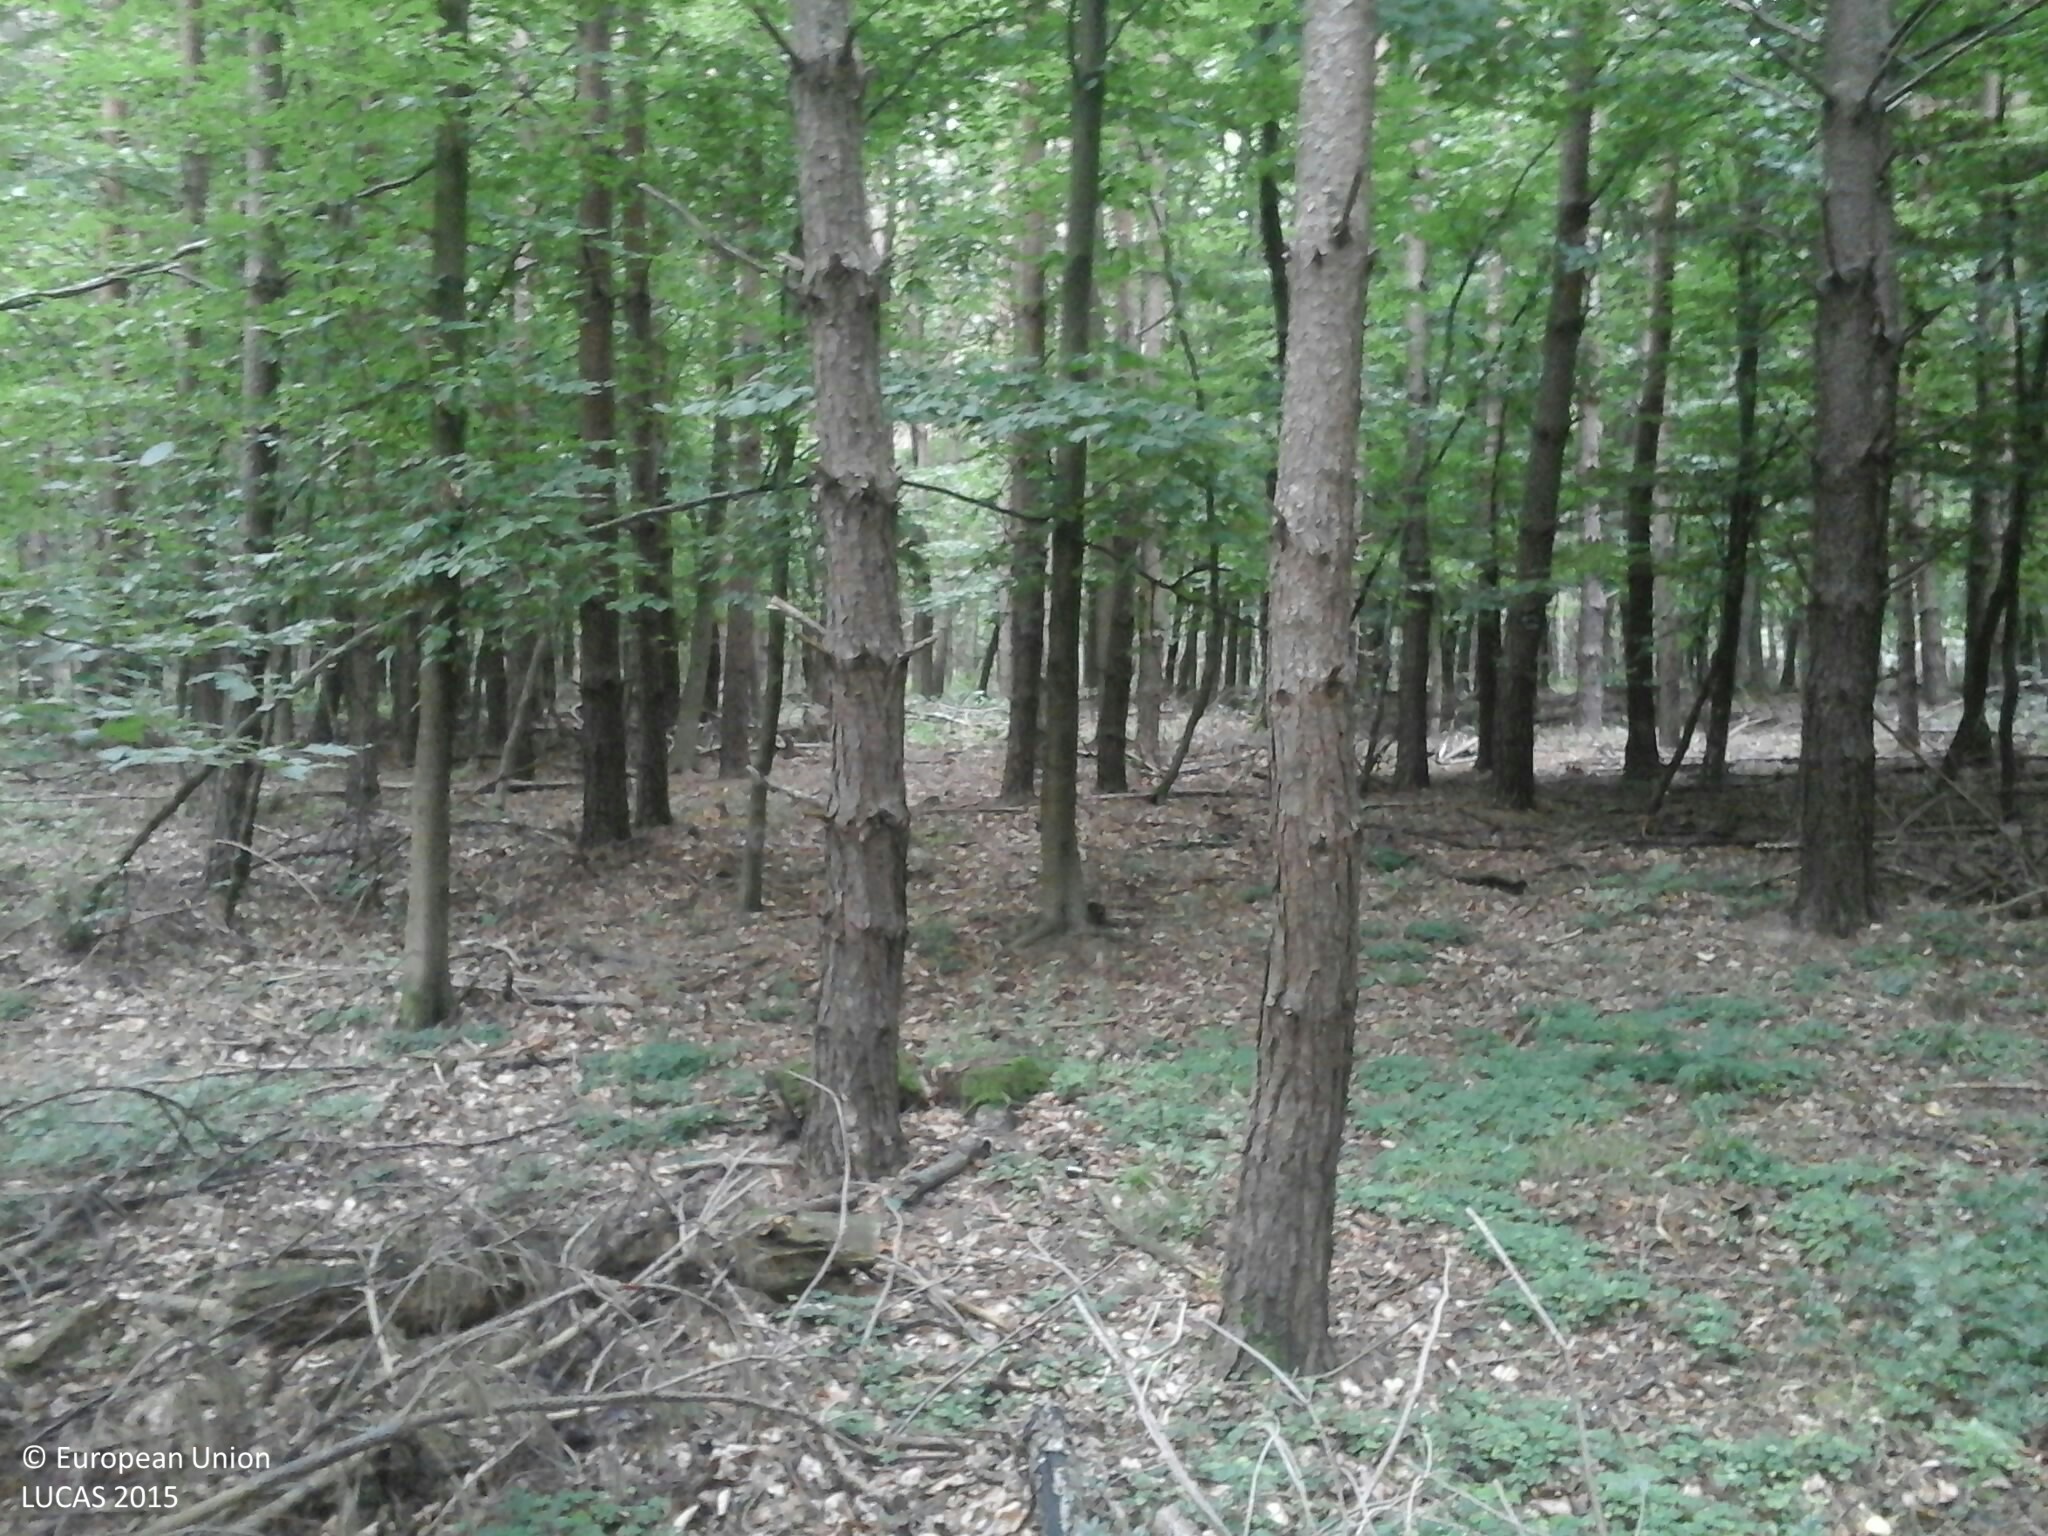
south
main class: Woodland
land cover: Pine dominated mixed woodland
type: hemiboreal forest and nemoral coniferous forest and mixed broadleaved-coniferous forest
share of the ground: > 75 %
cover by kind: coniferous forest trees 50 %, broadleaved forest trees 40 %, shrubs 5 %, herbaceous plants 5 %
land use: Forestry
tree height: > 5 m
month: July
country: HU
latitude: 46.7998
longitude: 16.5665
